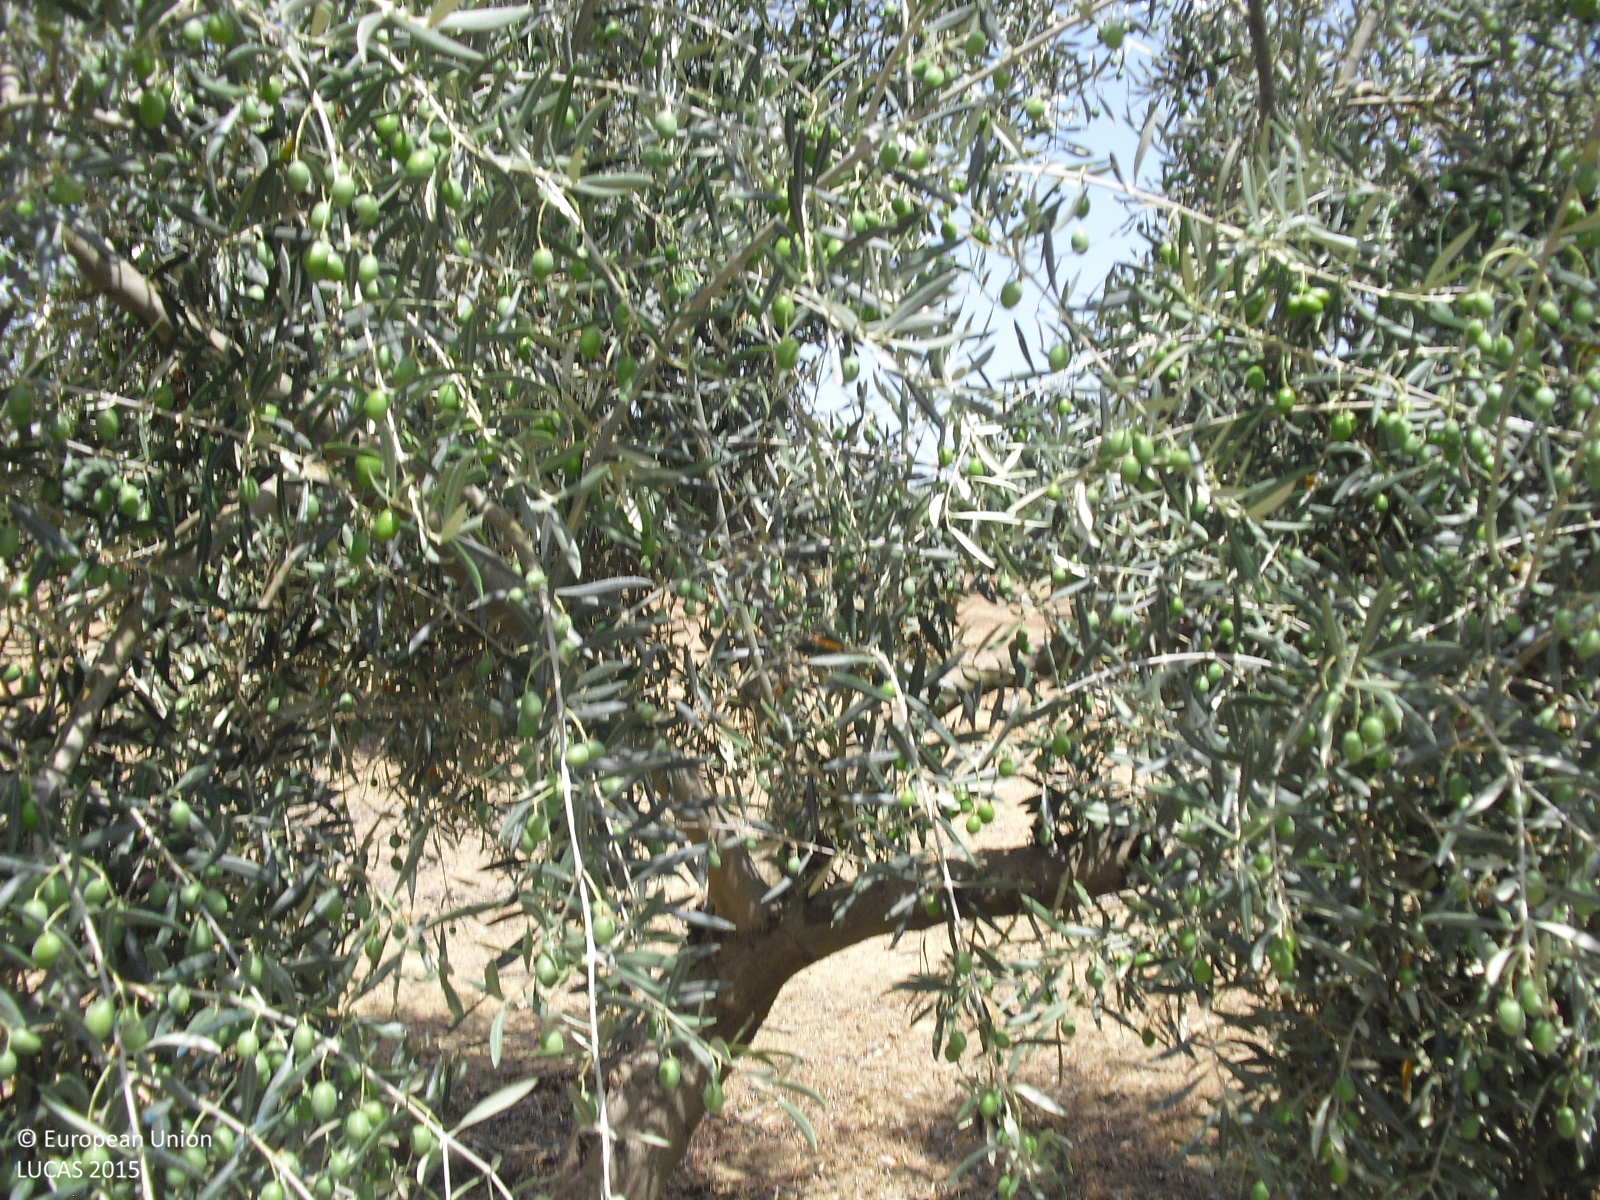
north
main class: Cropland
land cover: Olive groves
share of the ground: 10 - 25 %
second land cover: Other bare soil
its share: > 75 %
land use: Agriculture (excluding fallow land and kitchen gardens)
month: July
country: ES
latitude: 37.1738
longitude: -4.3114
